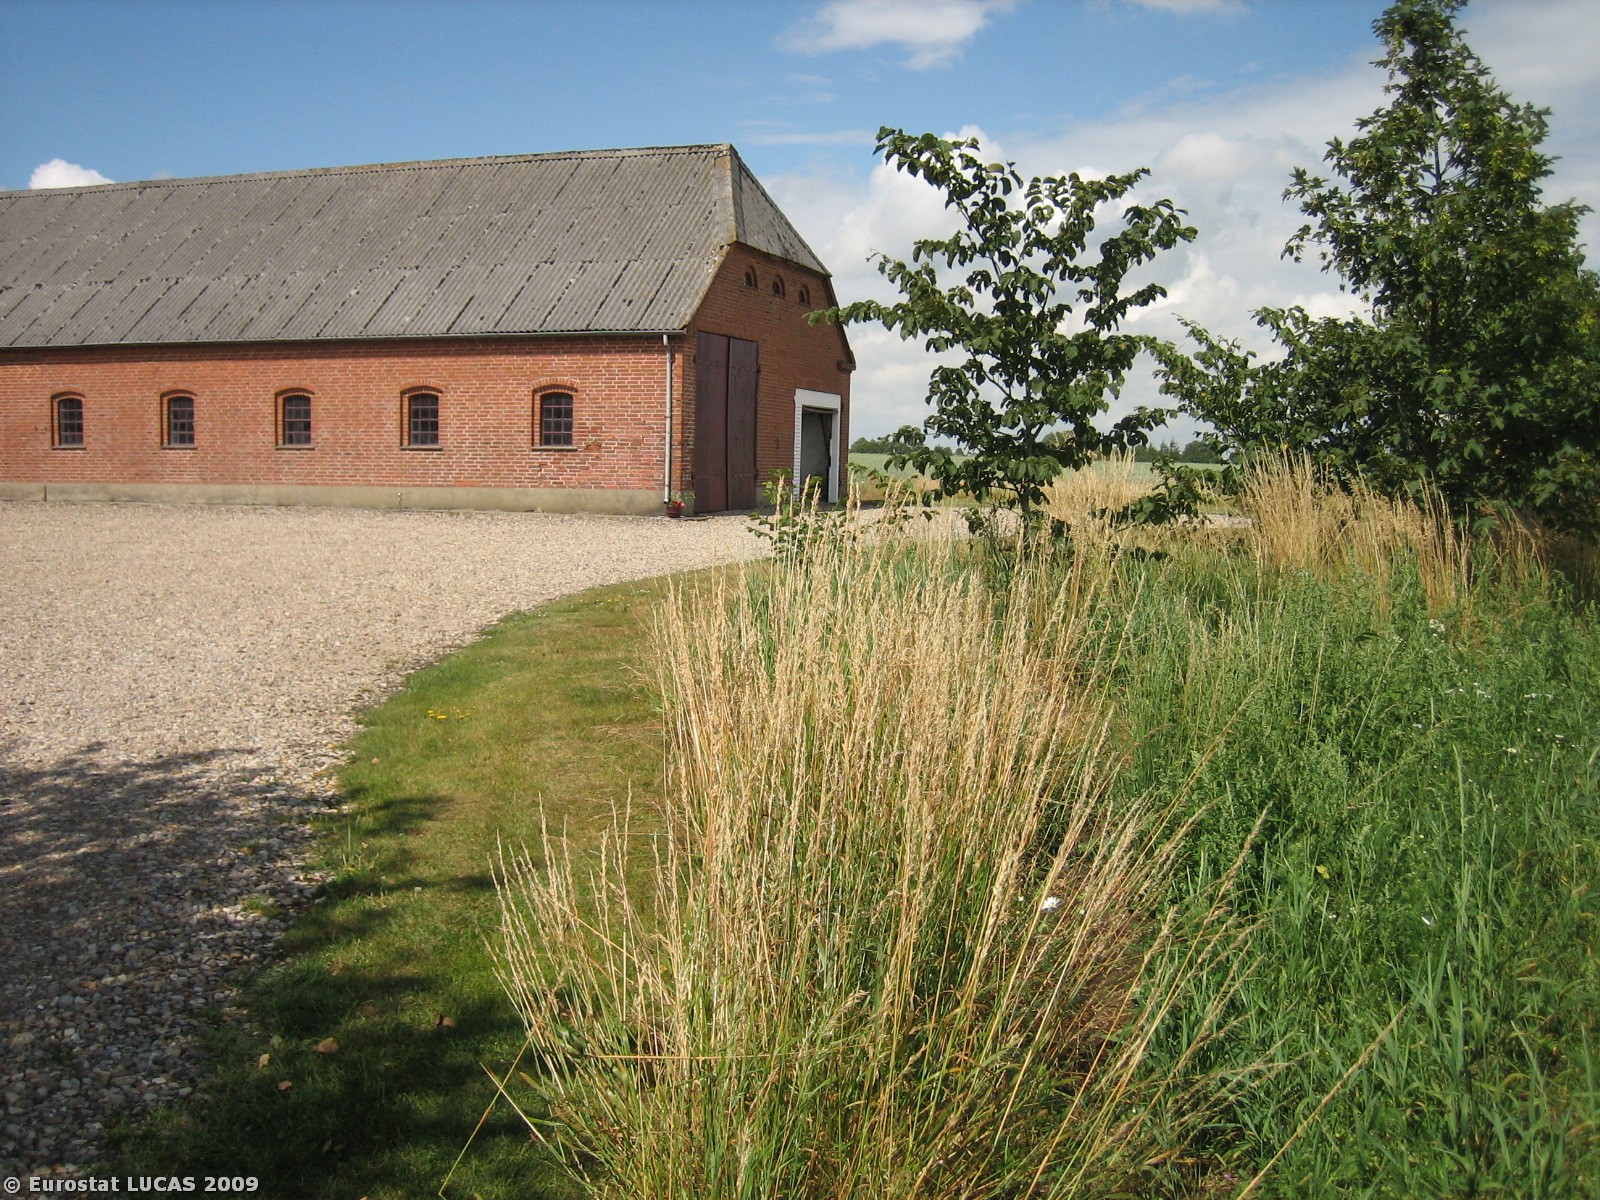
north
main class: Cropland
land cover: Common wheat
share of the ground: > 75 %
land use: Agriculture (excluding fallow land and kitchen gardens)
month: July
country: DK
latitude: 55.6070
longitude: 8.8106
